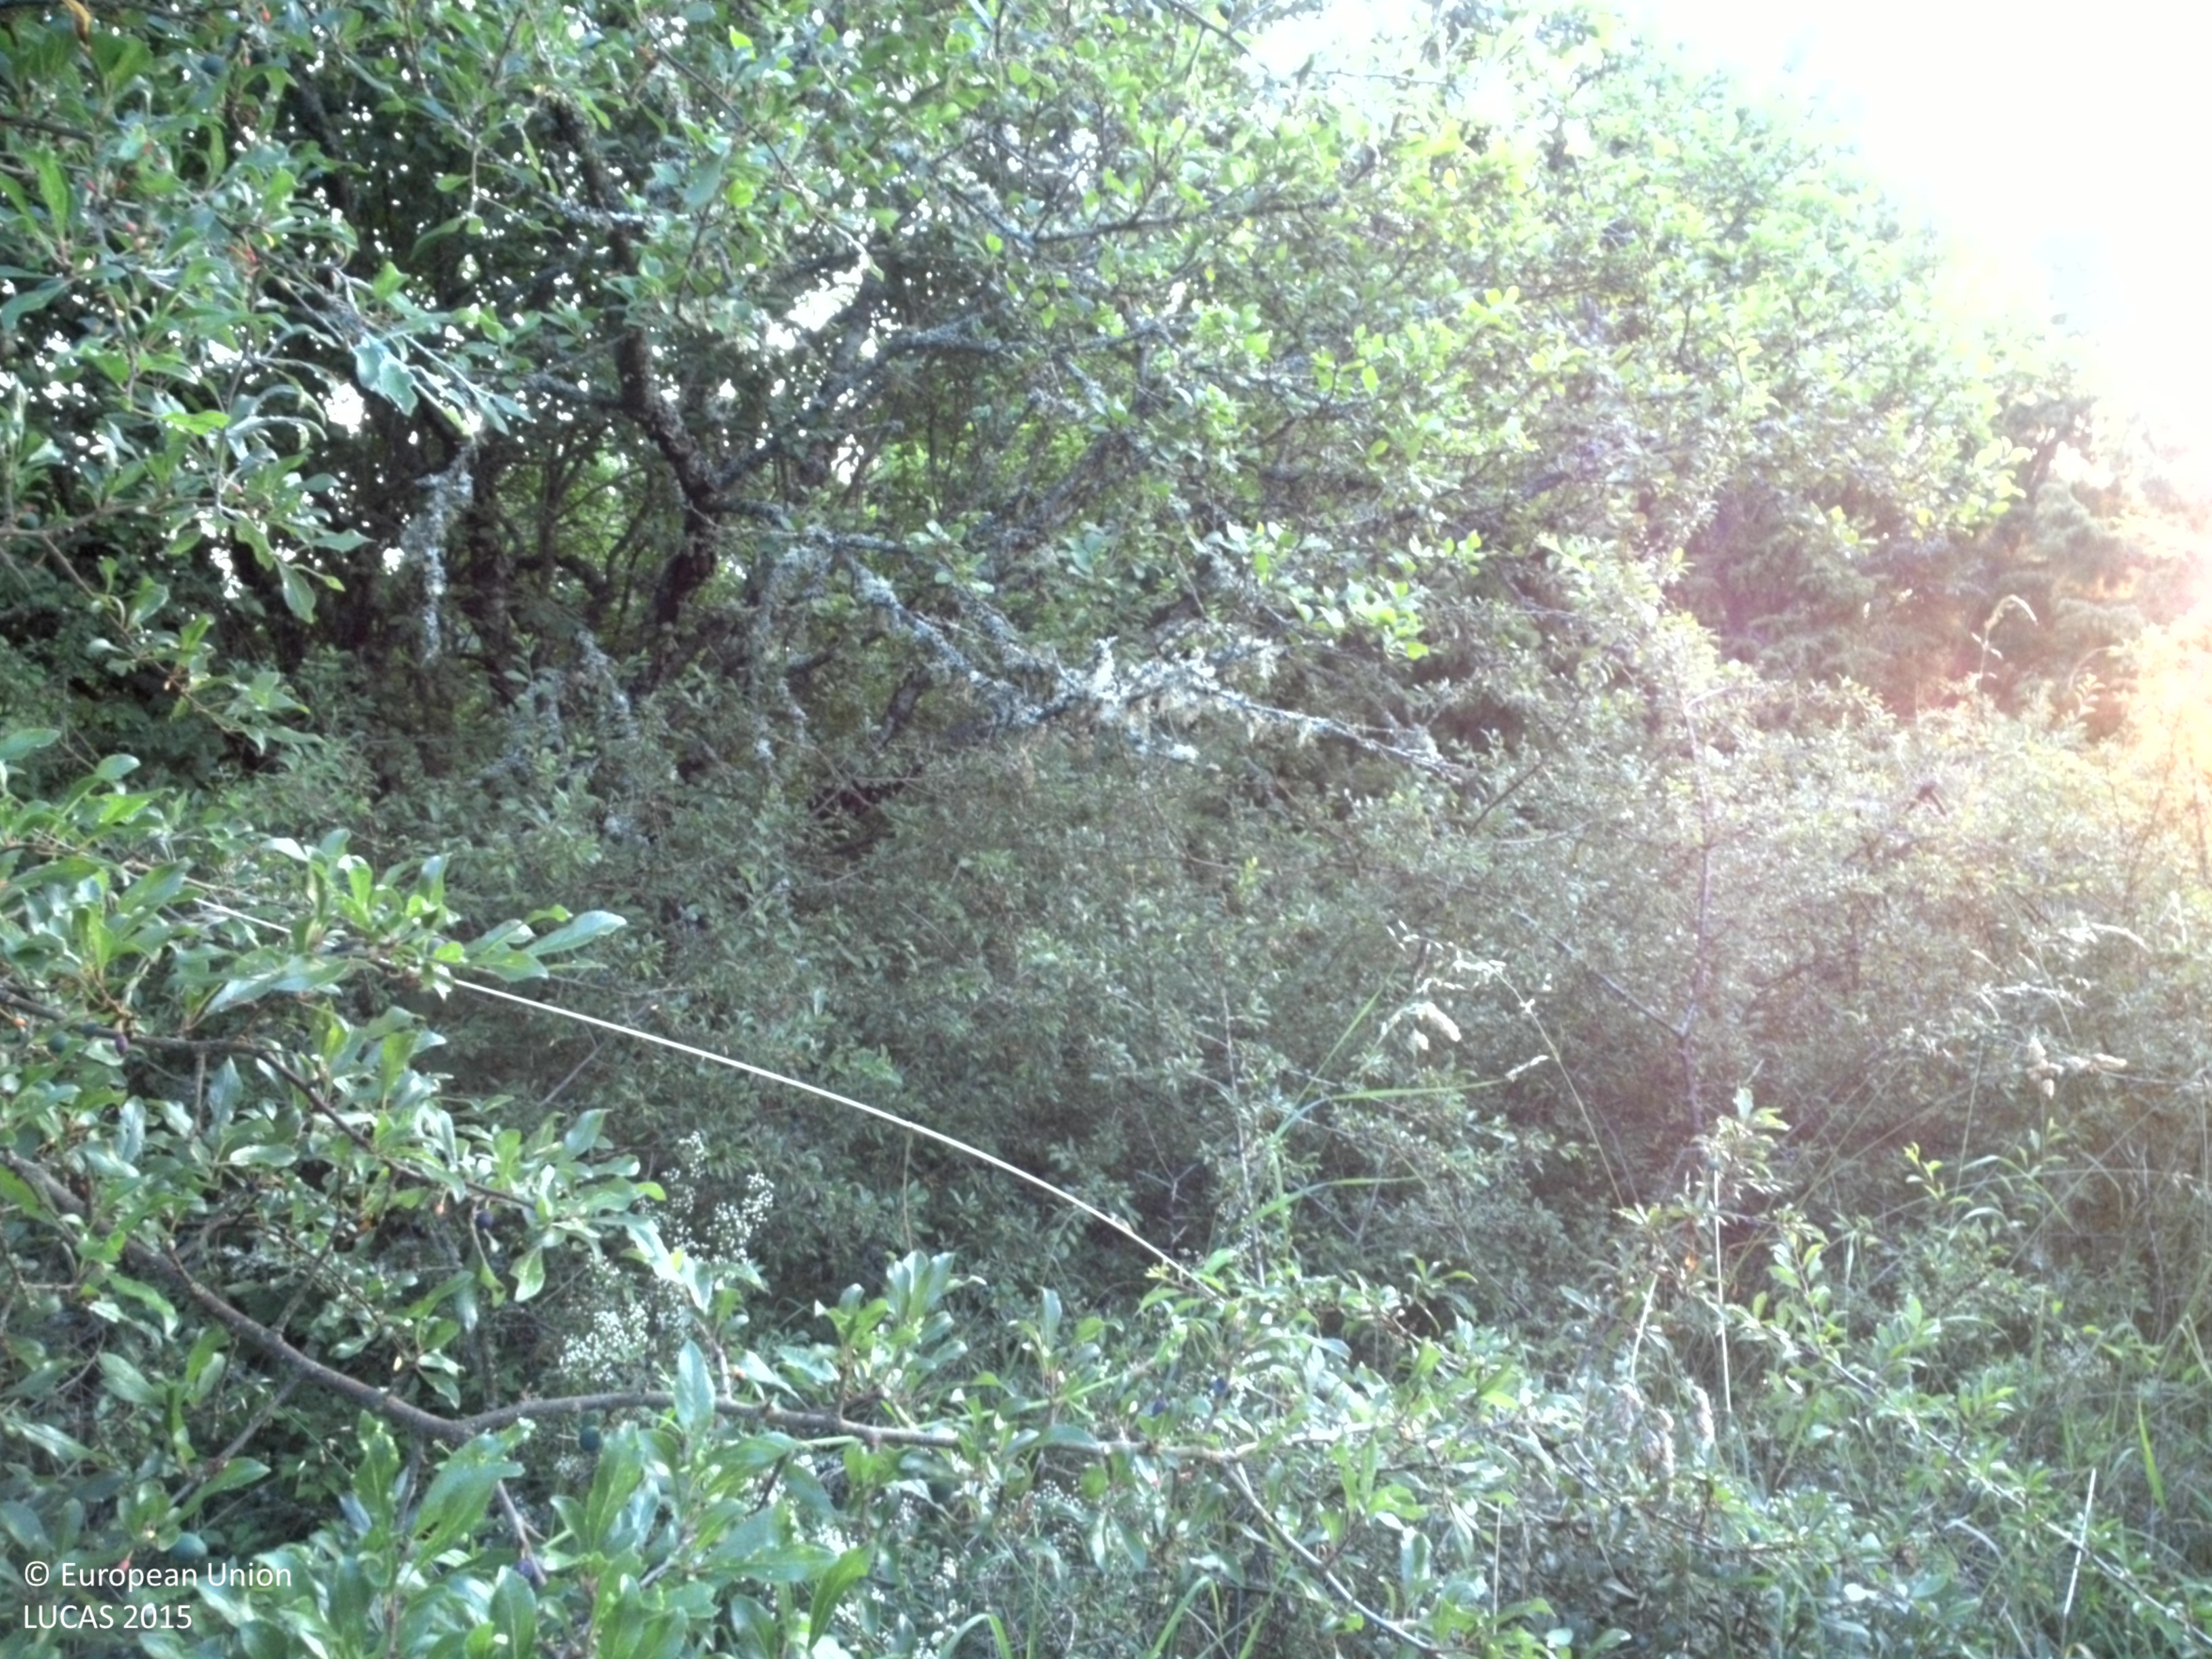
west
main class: Shrubland
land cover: Shrubland with sparse tree cover
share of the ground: > 75 %
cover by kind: shrubs 95 %, broadleaved forest trees 5 %
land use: Amenities, museums, leisure
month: July
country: SE
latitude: 57.6427
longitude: 18.7716
